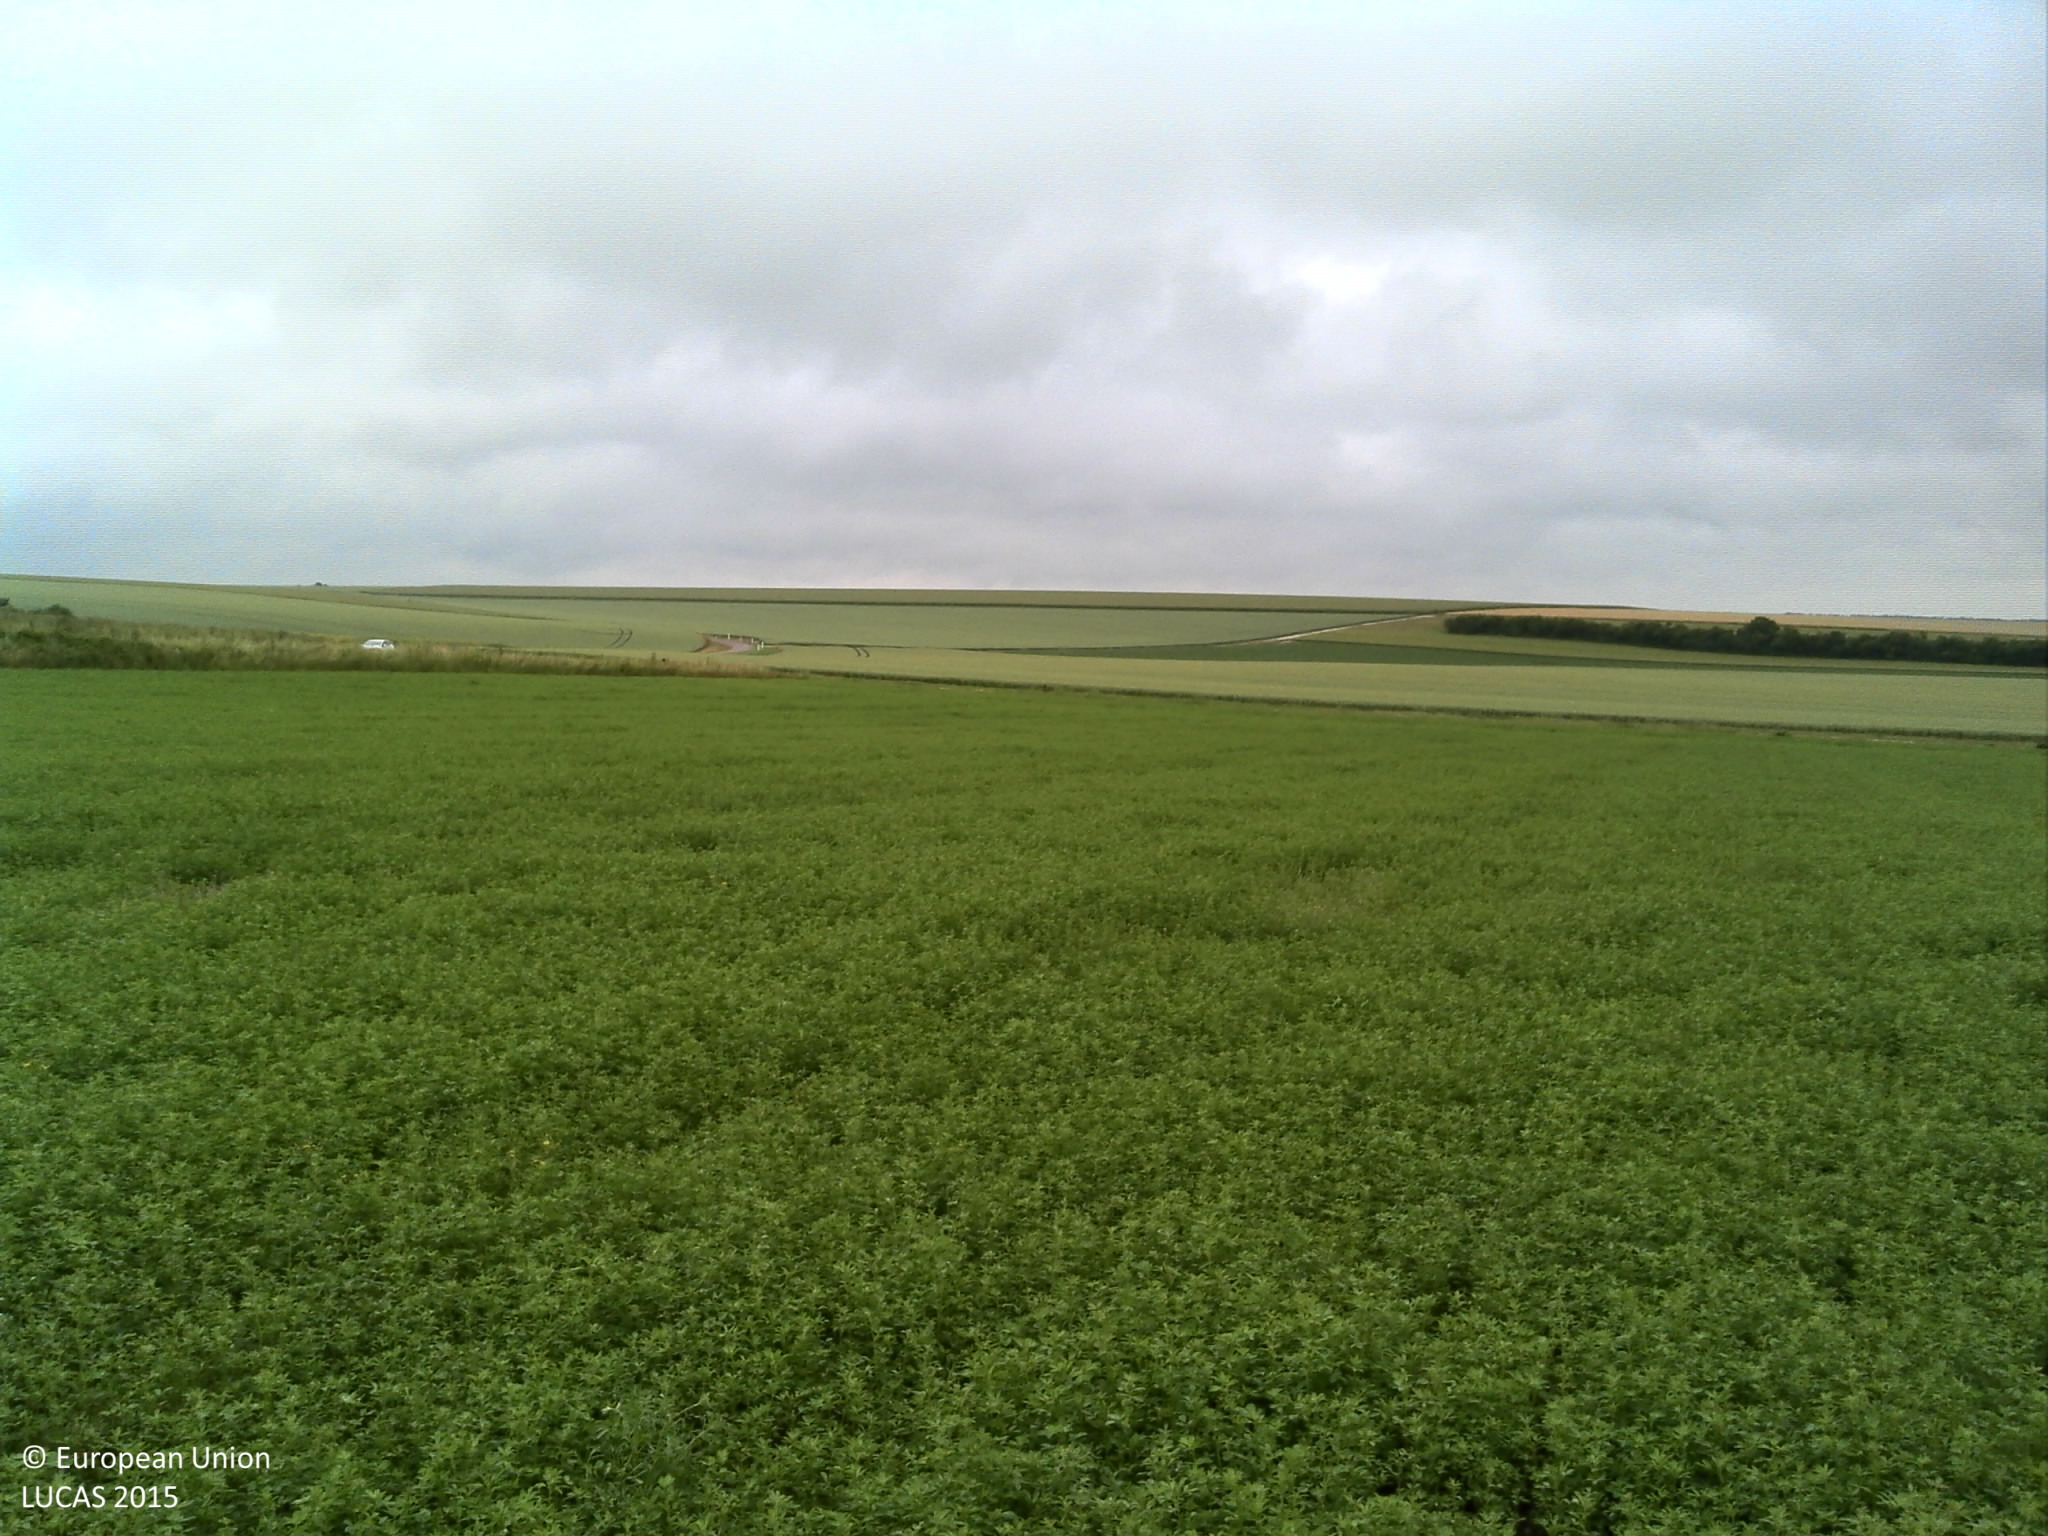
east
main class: Cropland
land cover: Lucerne
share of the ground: > 75 %
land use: Agriculture (excluding fallow land and kitchen gardens)
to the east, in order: Lucerne; Grass margins; Tracks; Grass margins; Common wheat
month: June
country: FR
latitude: 48.6302
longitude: 4.2025
